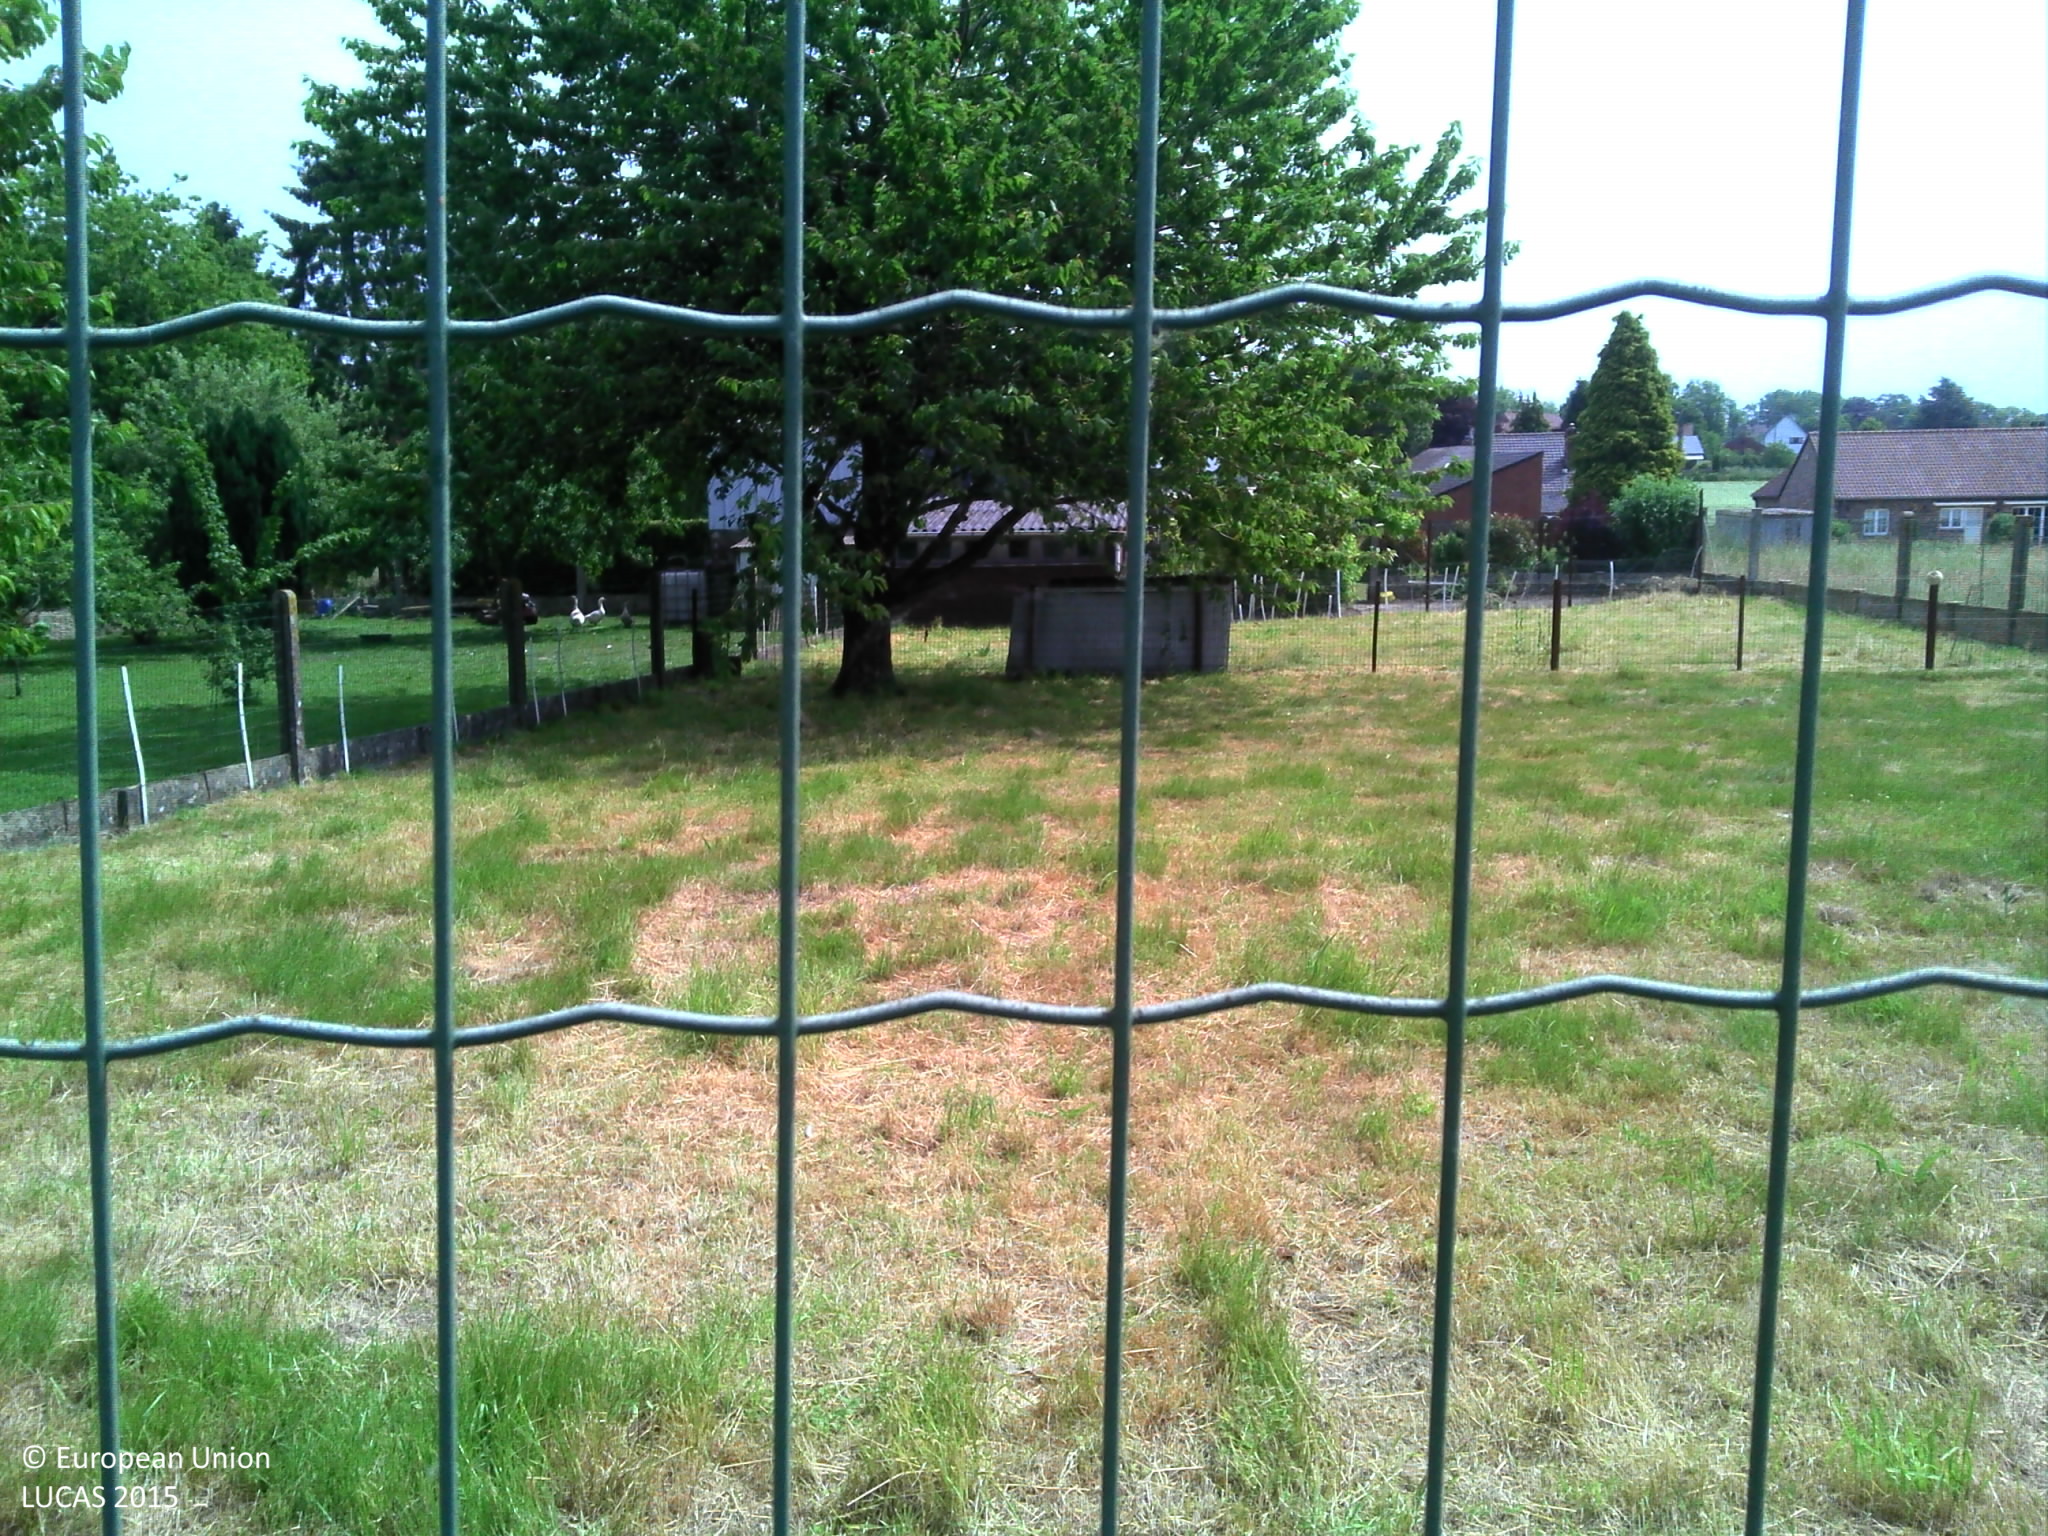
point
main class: Grassland
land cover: Grassland with sparse tree/shrub cover
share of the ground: > 75 %
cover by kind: herbaceous plants 95 %, broadleaved forest trees 5 %
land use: Residential
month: June
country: BE
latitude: 50.4817
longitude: 3.7502
